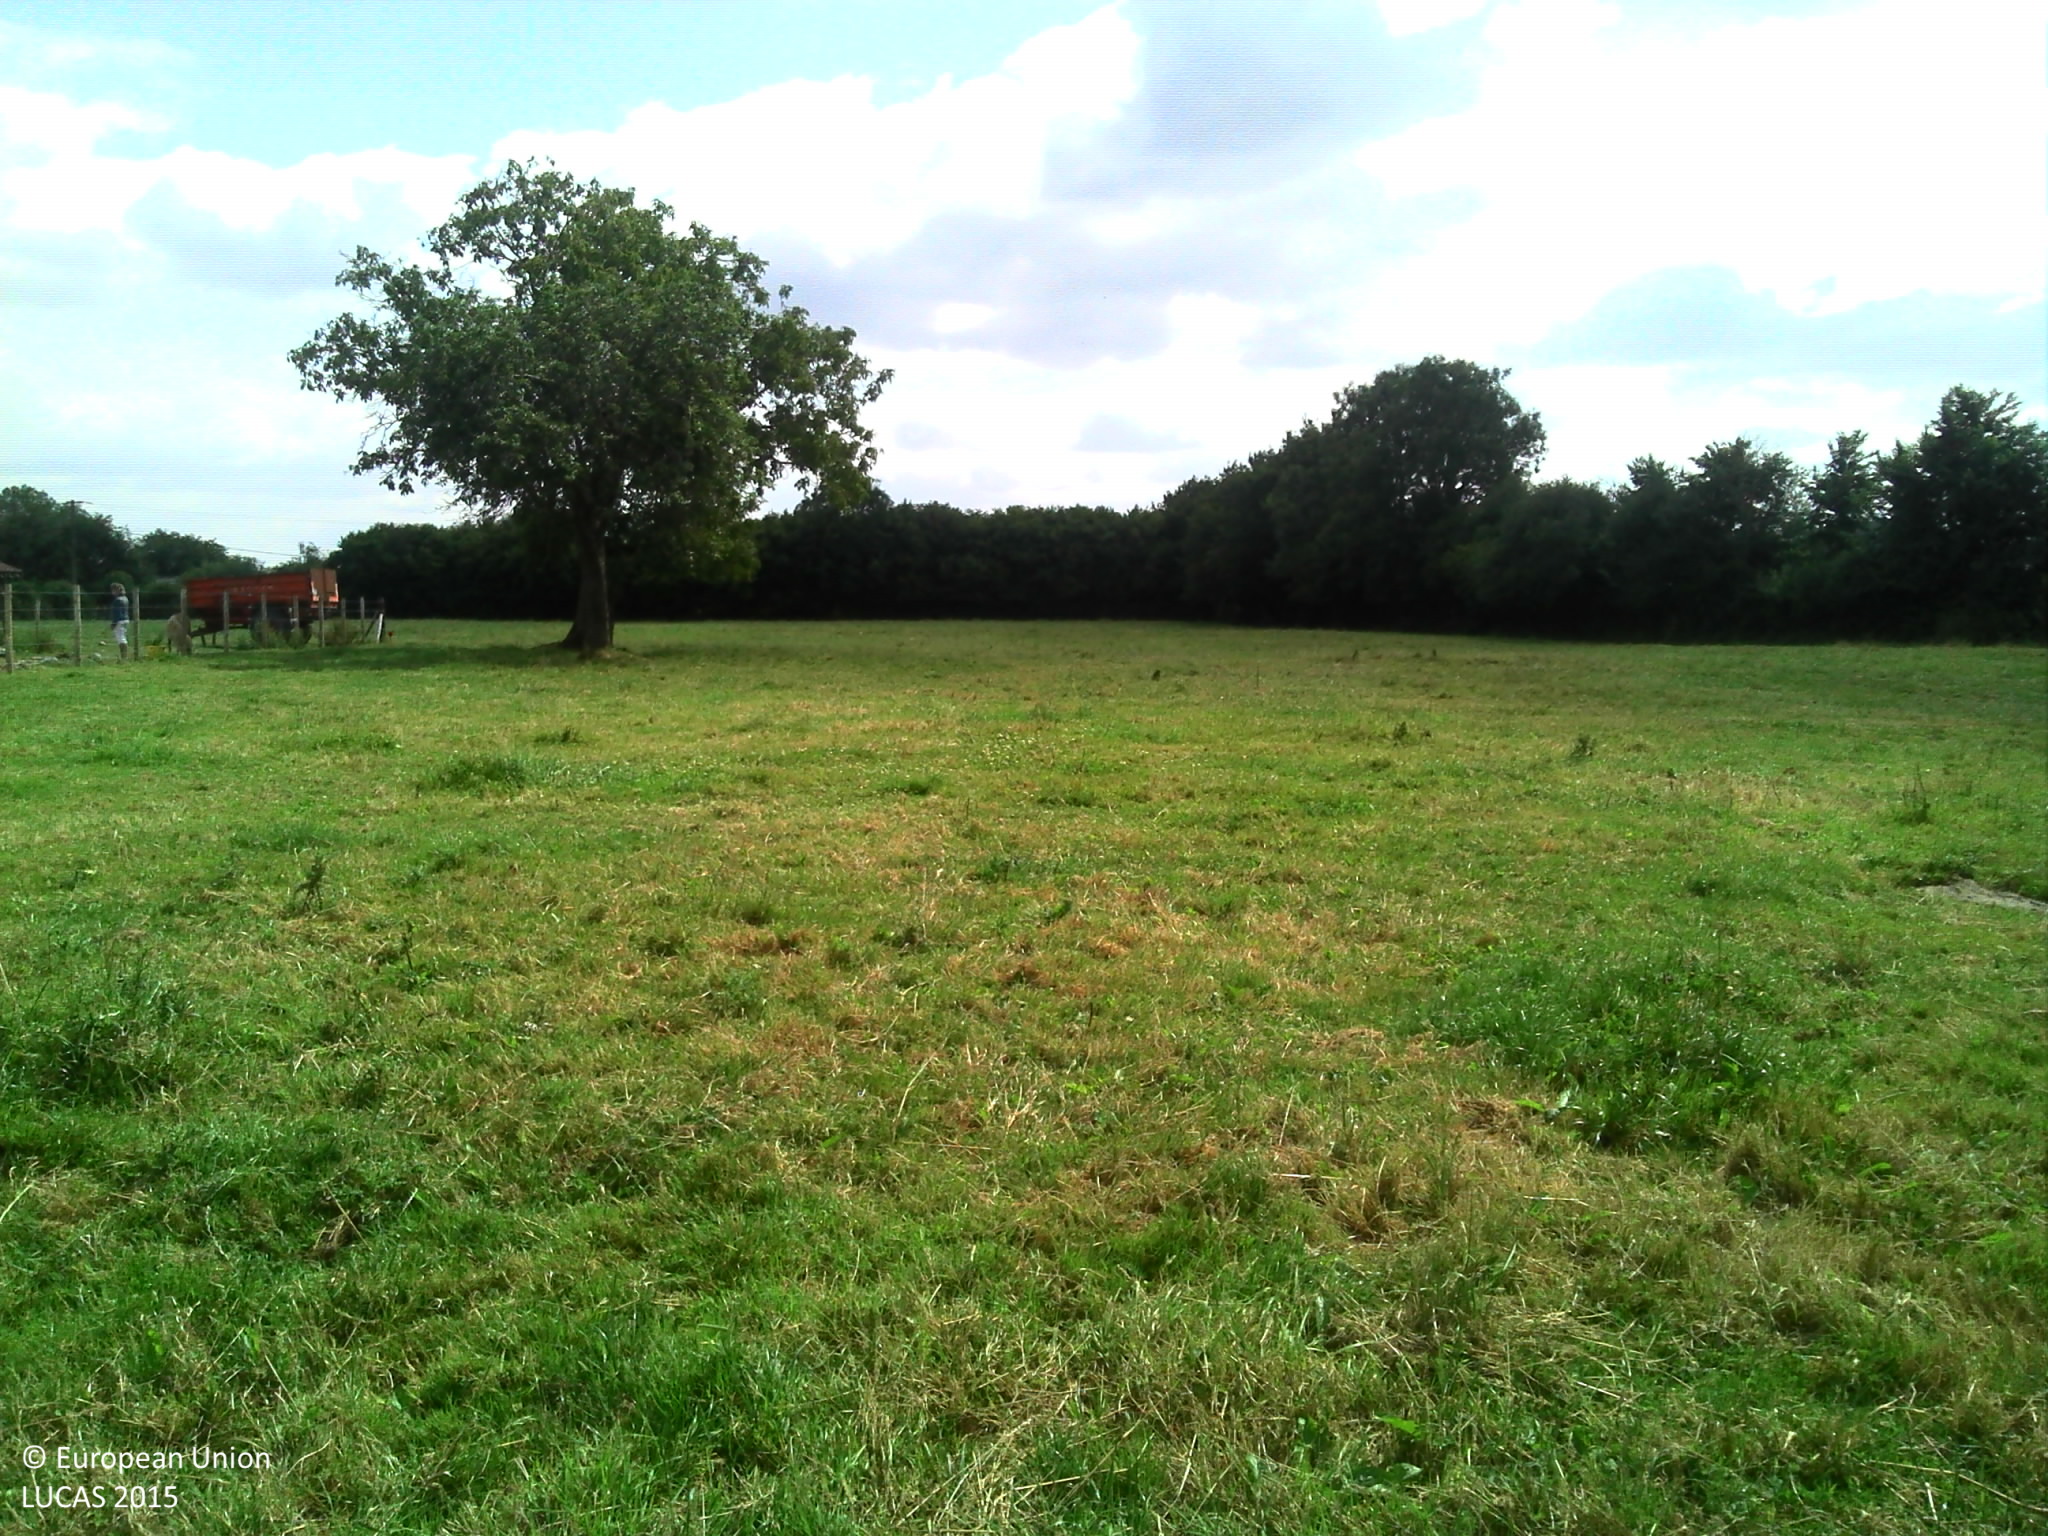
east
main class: Grassland
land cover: Grassland with sparse tree/shrub cover
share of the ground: > 75 %
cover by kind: herbaceous plants 95 %, broadleaved forest trees 5 %
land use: Agriculture (excluding fallow land and kitchen gardens)
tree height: > 5 m
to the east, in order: Grassland with sparse tree/shrub cover; Grassland without tree/shrub cover; Fences; Abandoned hedges; Grassland without tree/shrub cover; Fences; Grassland without tree/shrub cover
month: July
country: FR
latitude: 49.1281
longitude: 0.4214
